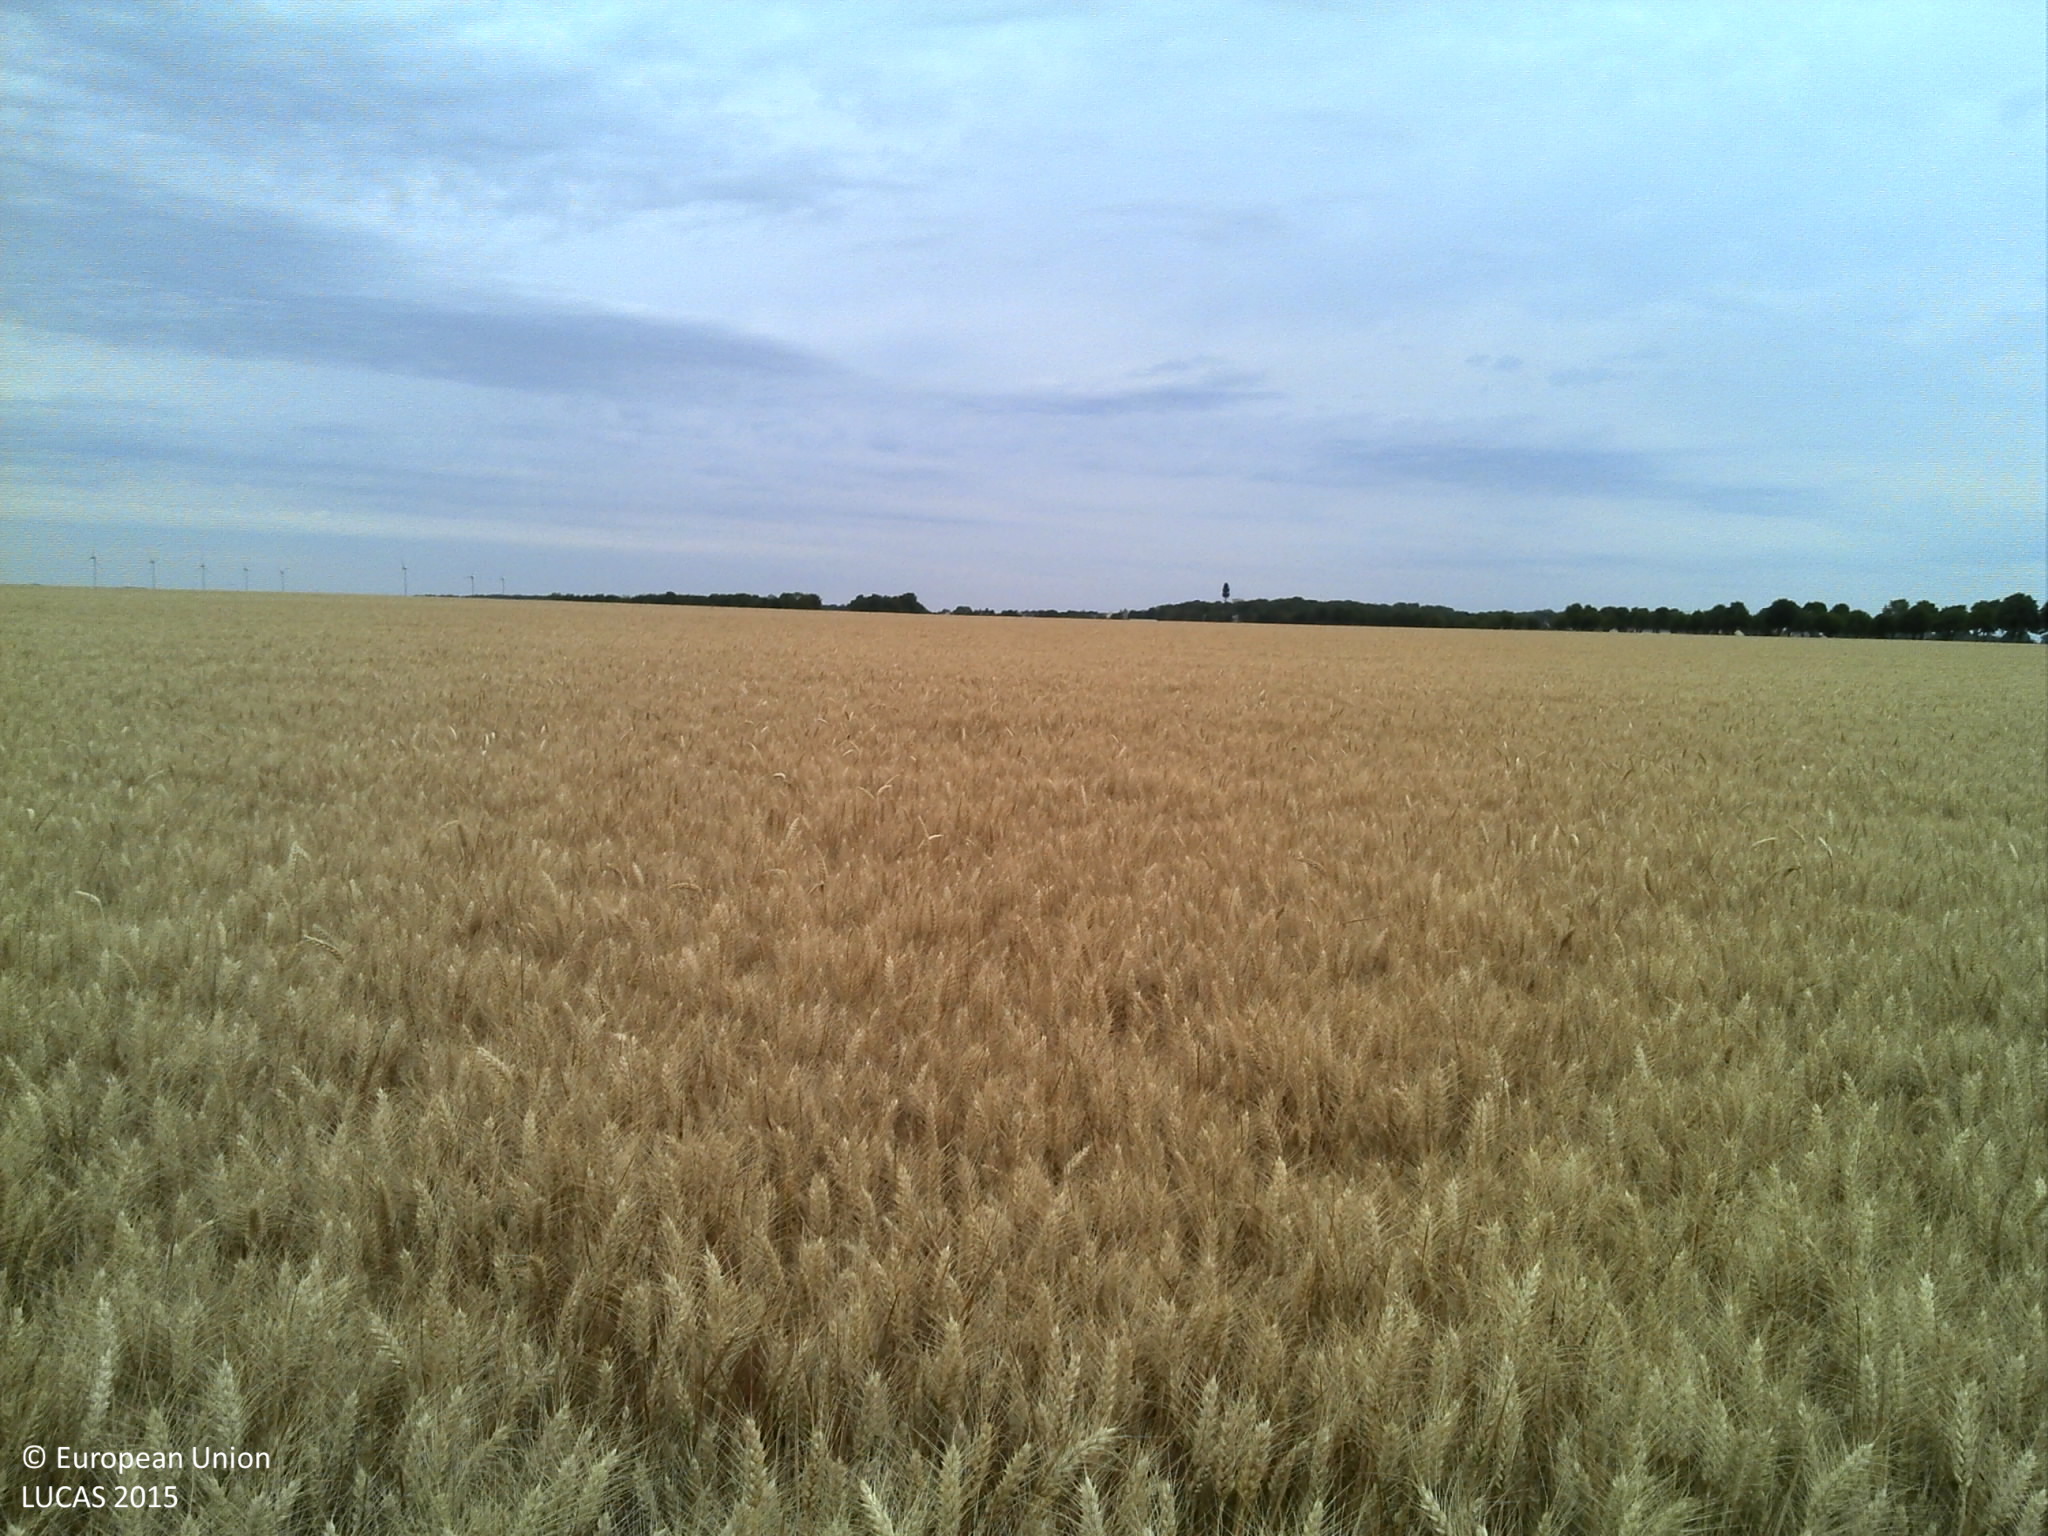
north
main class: Cropland
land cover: Durum wheat
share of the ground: > 75 %
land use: Agriculture (excluding fallow land and kitchen gardens)
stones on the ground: < 10 %
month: July
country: FR
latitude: 48.3294
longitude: 1.9881
